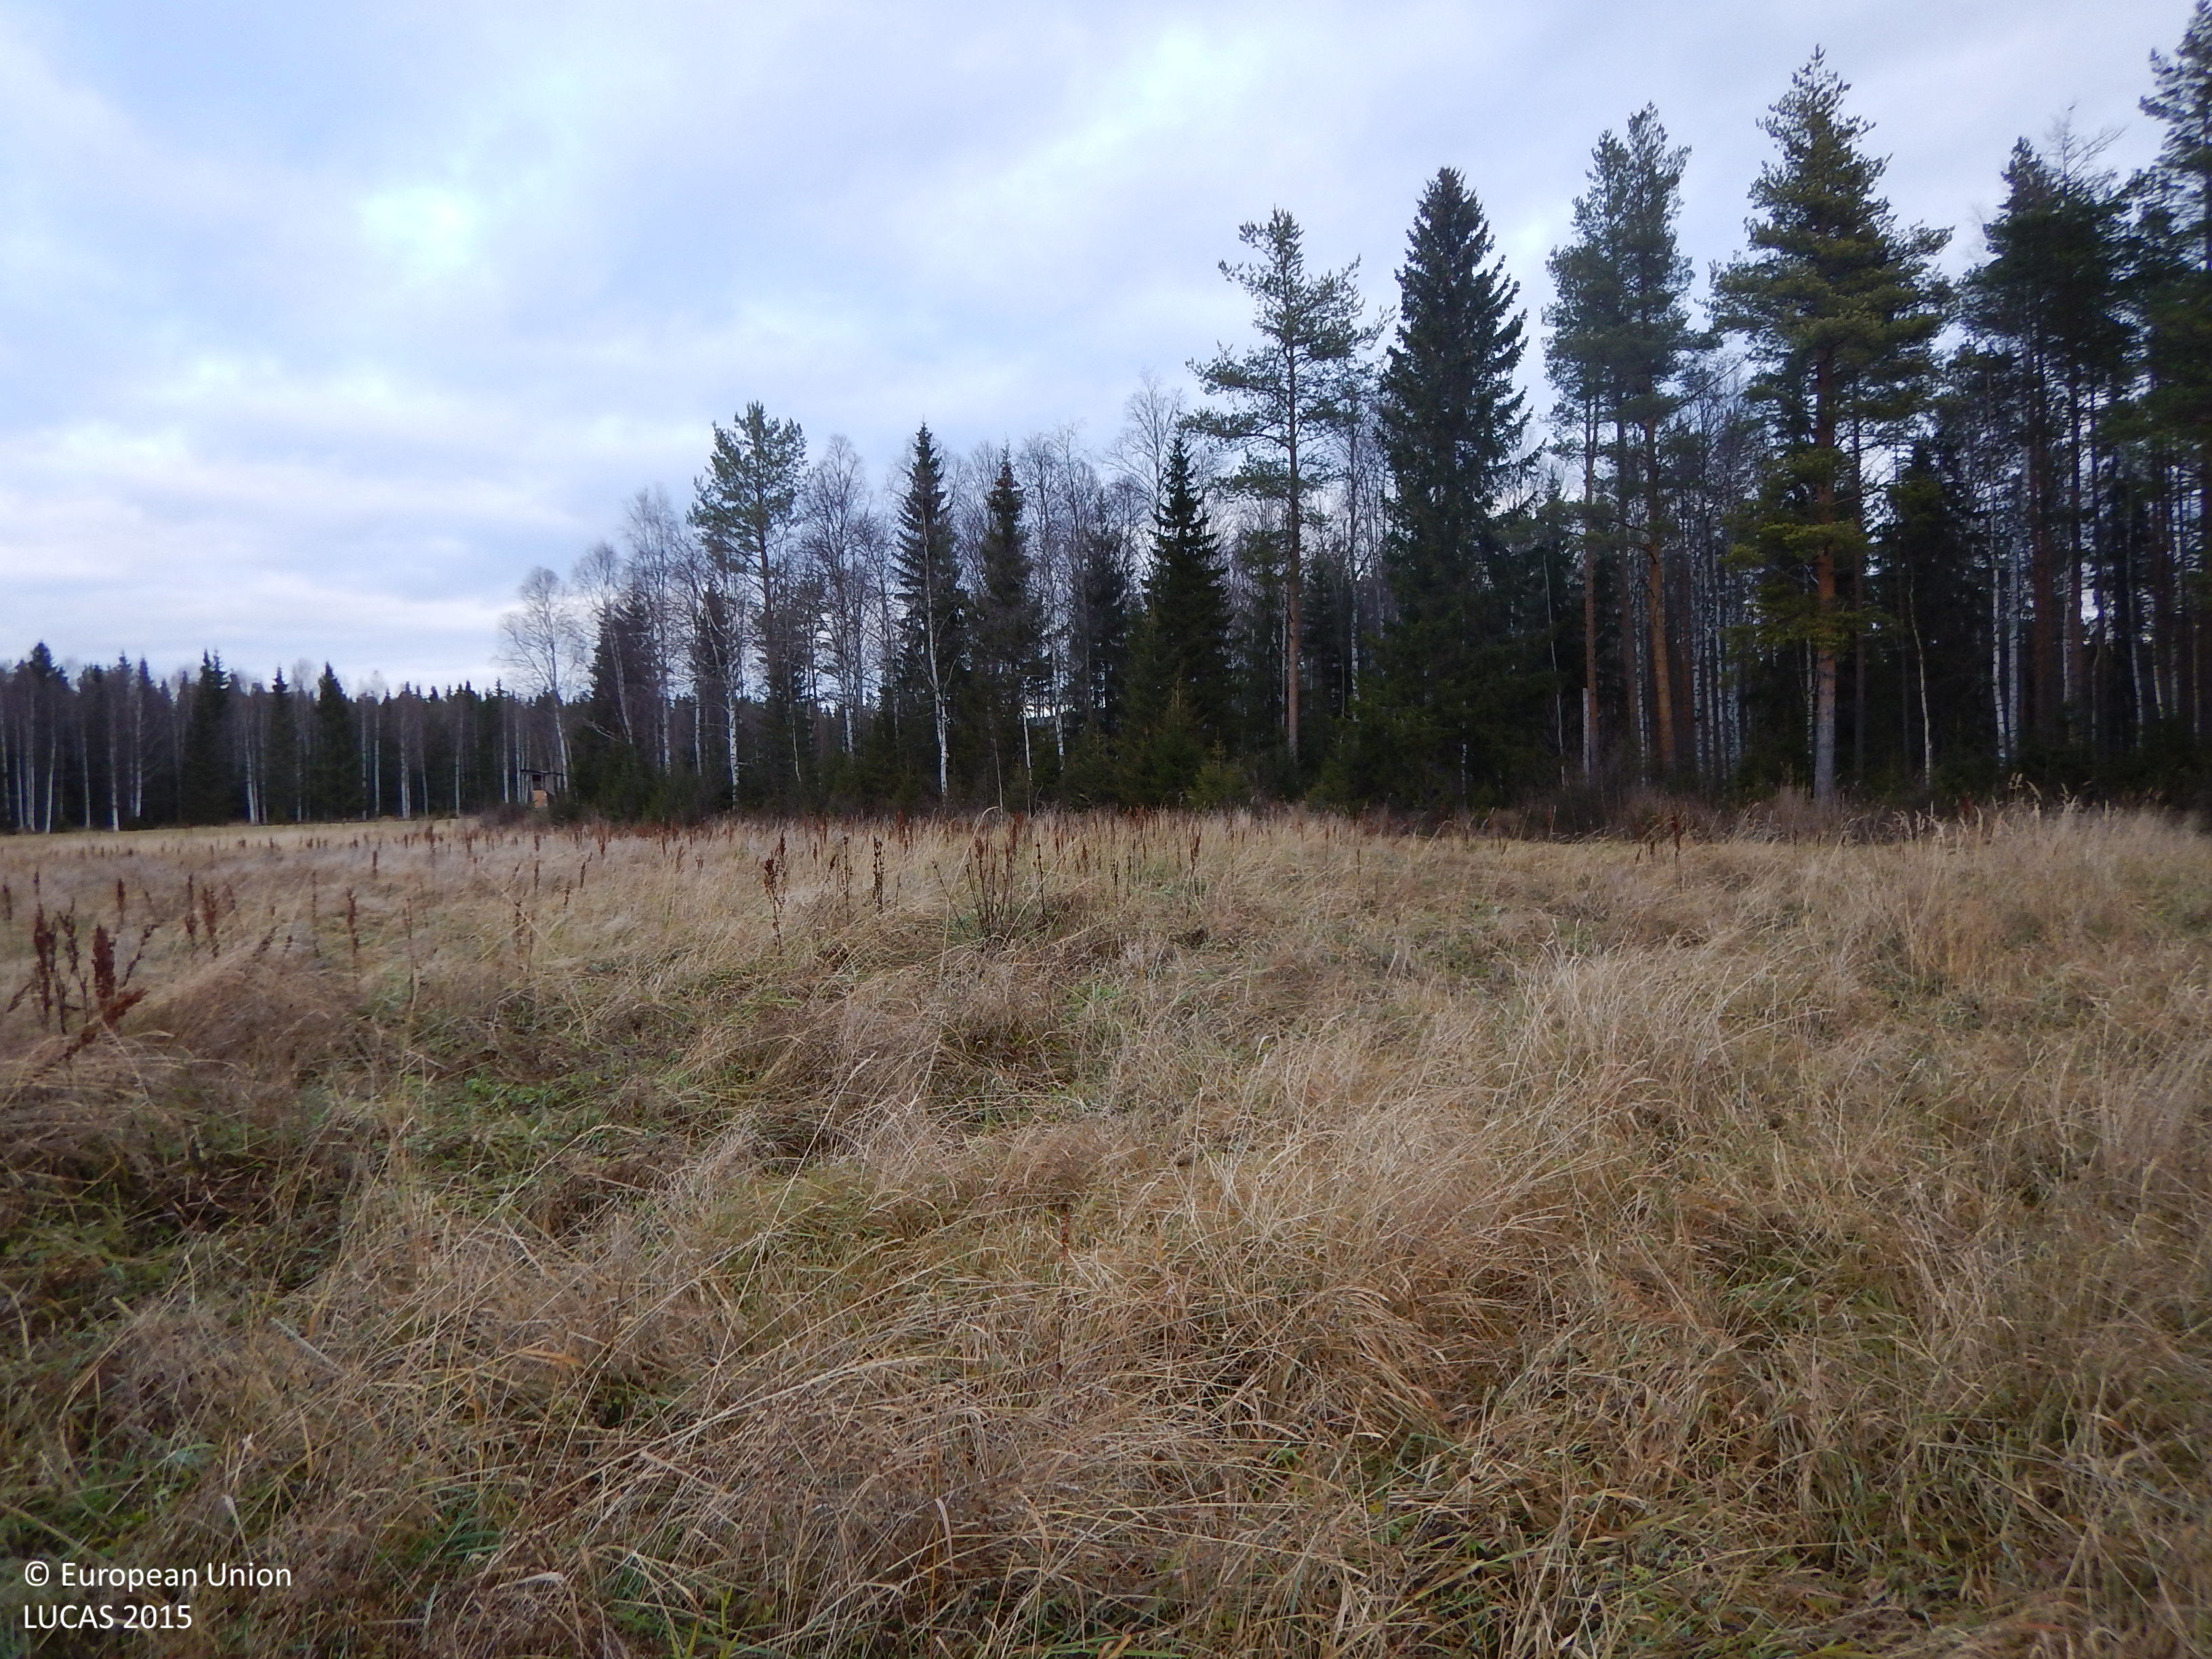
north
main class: Grassland
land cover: Grassland without tree/shrub cover
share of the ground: > 75 %
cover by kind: herbaceous plants 95 %, shrubs 5 %
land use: Agriculture (excluding fallow land and kitchen gardens)
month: November
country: SE
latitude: 65.3971
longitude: 21.1015
